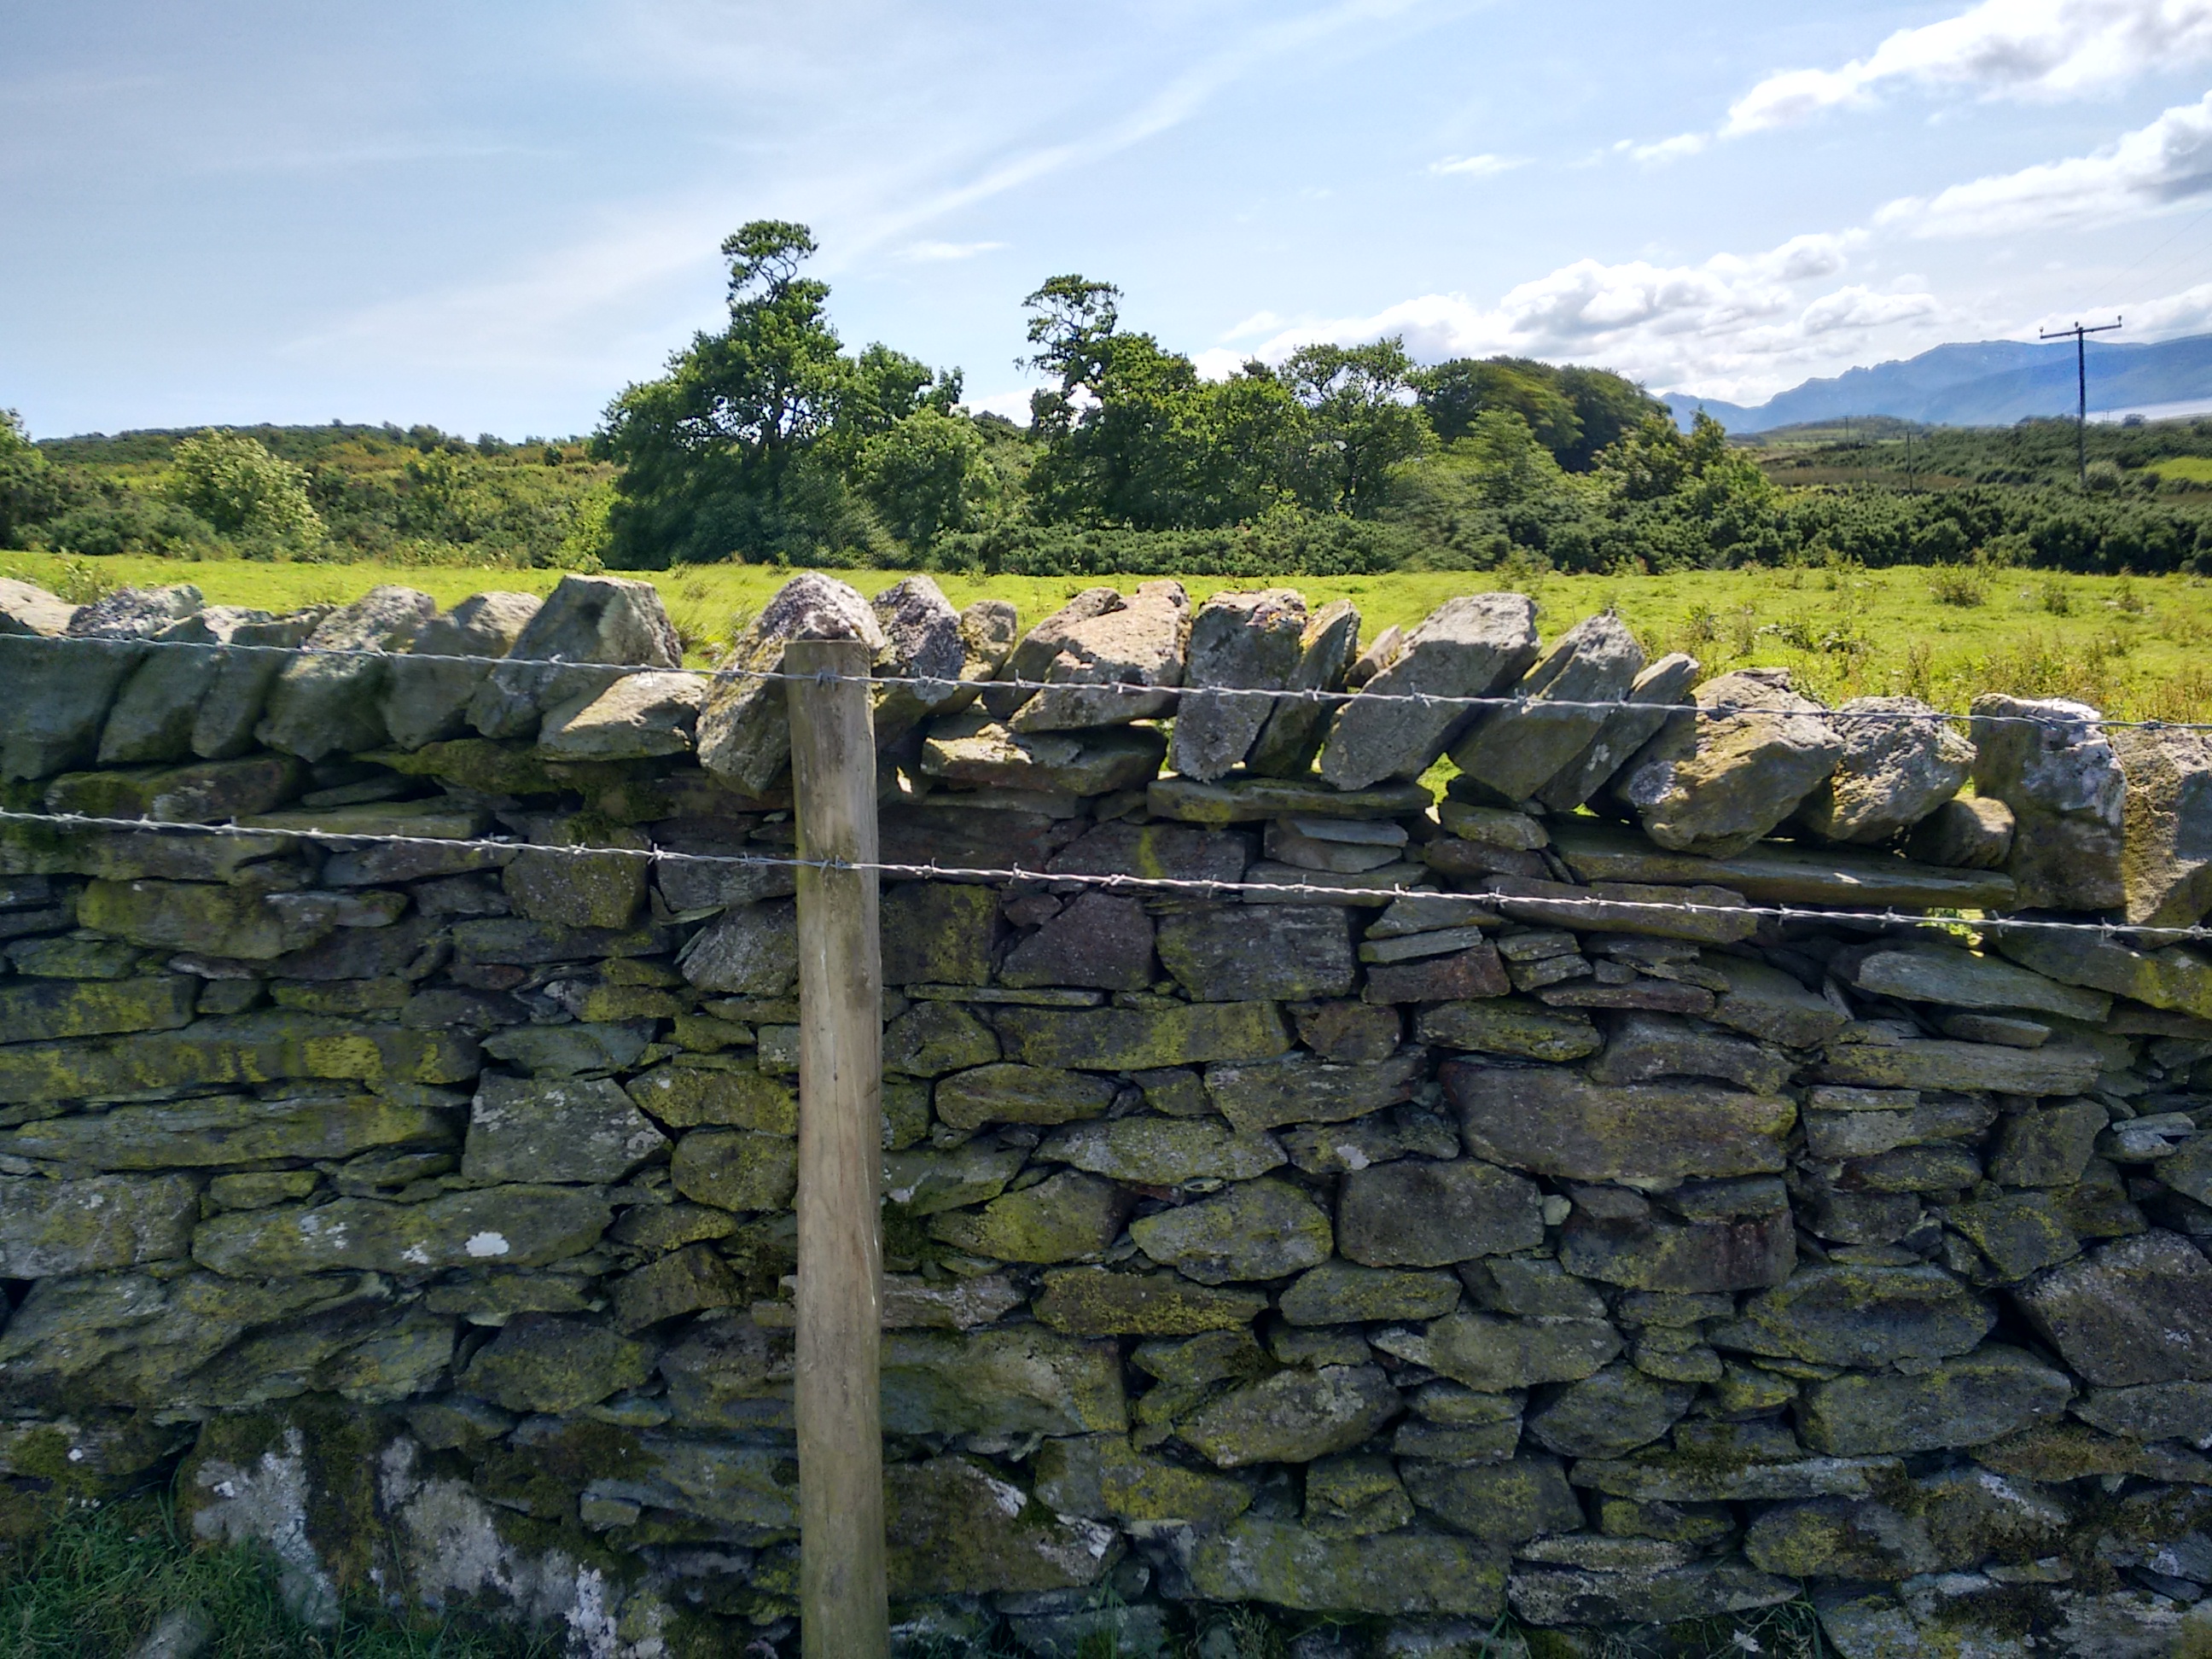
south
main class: Grassland
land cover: Grassland without tree/shrub cover
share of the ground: > 75 %
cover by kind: herbaceous plants 95 %, shrubs 5 %
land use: Agriculture (excluding fallow land and kitchen gardens)
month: July
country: GB
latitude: 55.8183
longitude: -5.0993
